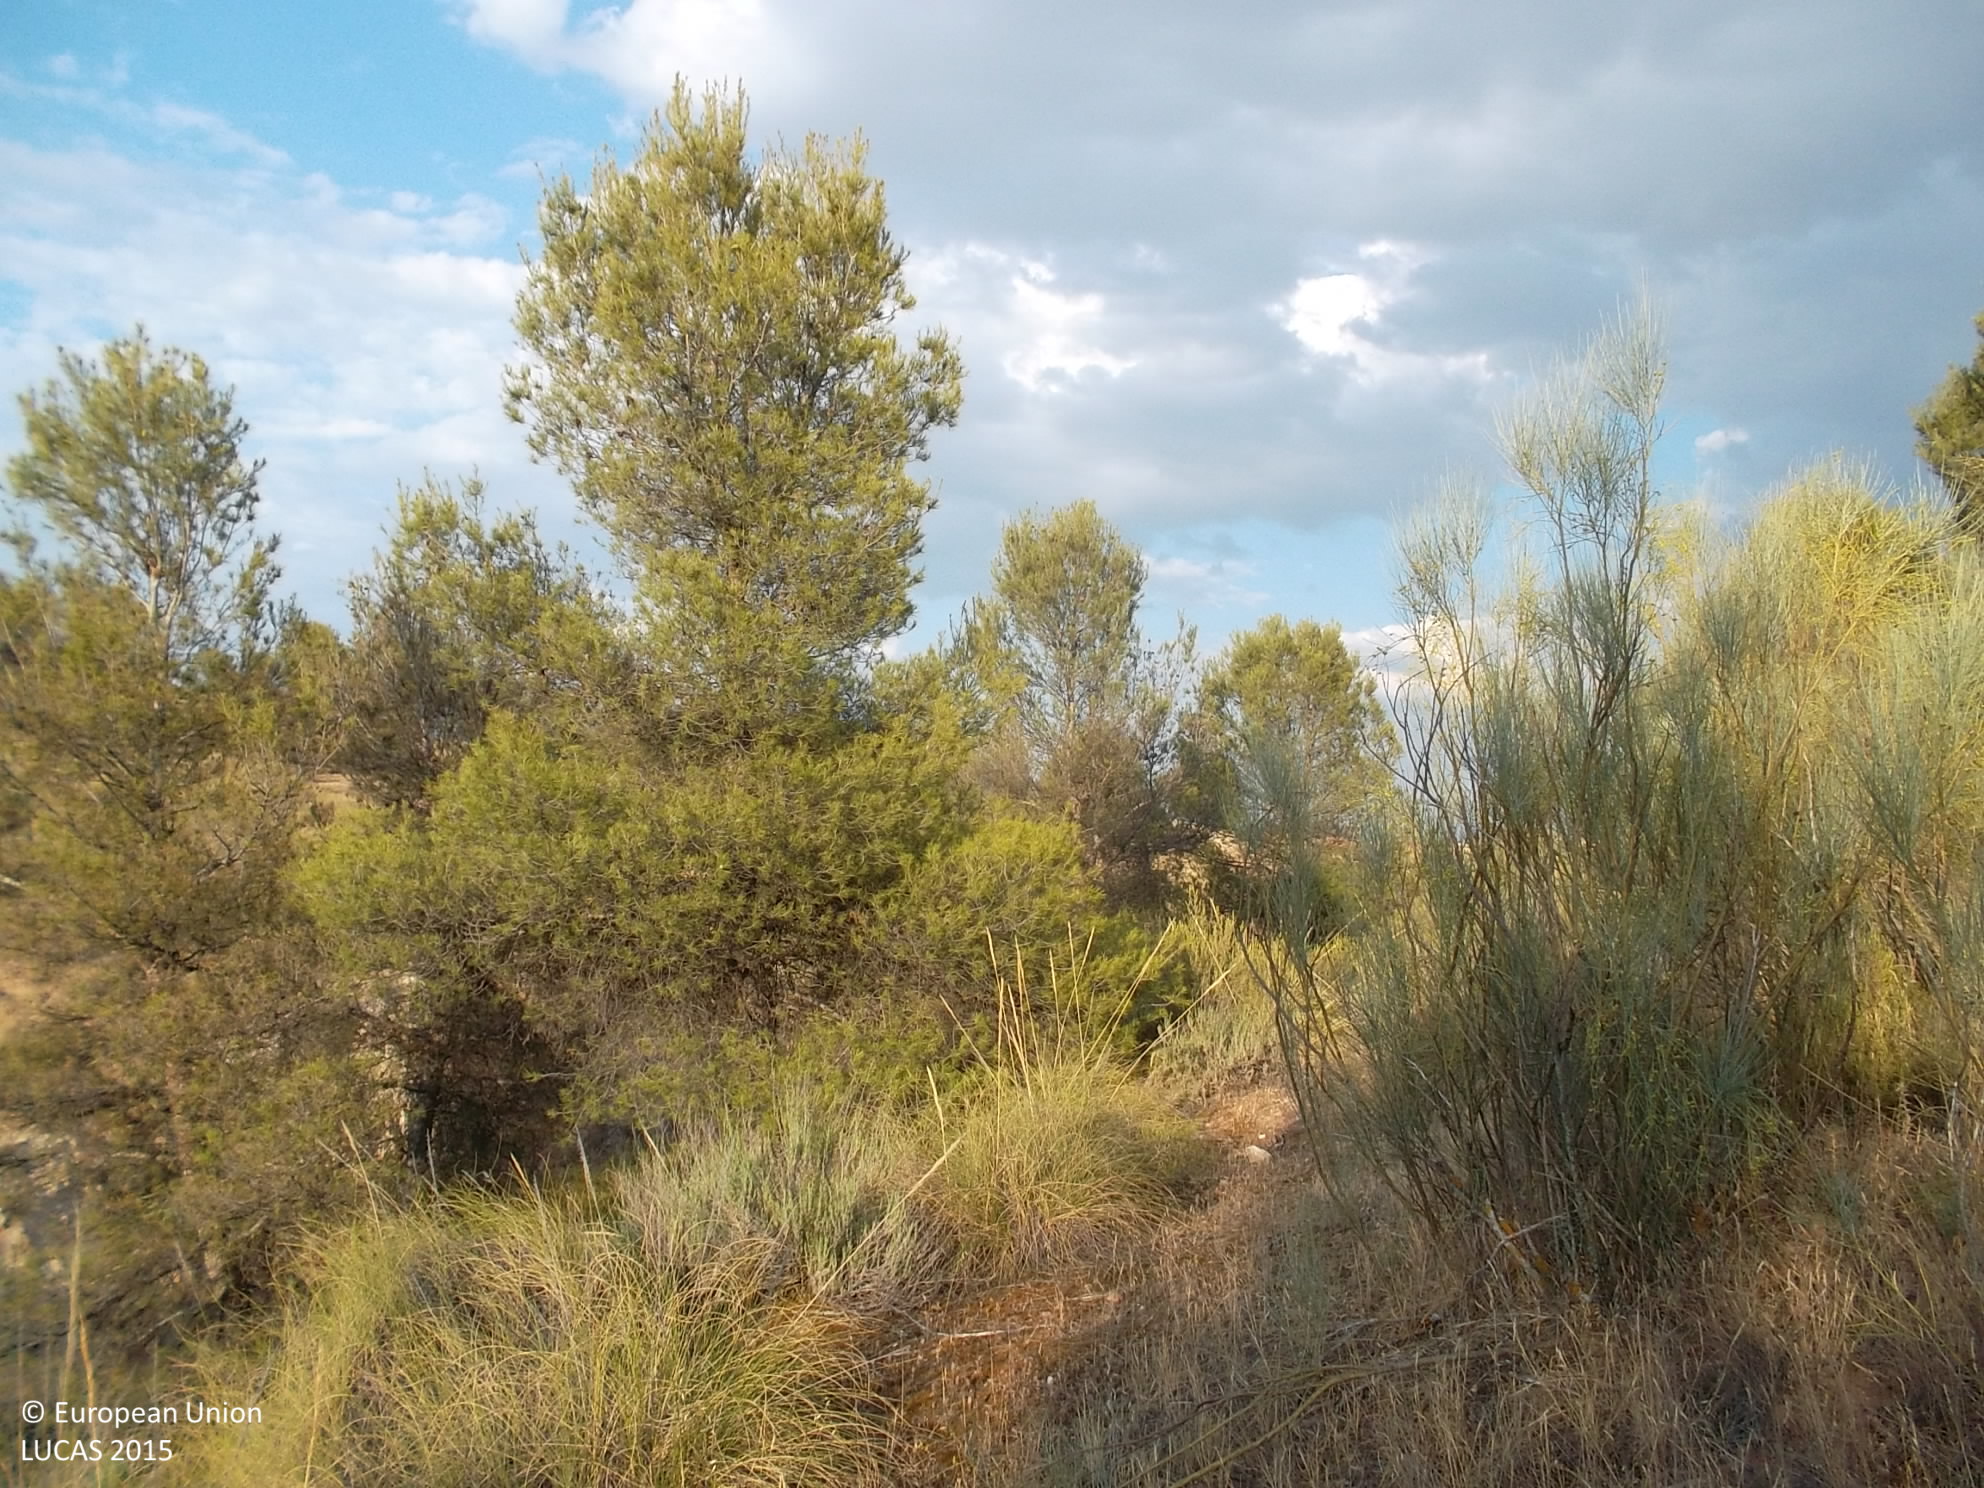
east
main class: Woodland
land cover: Pine dominated coniferous woodland
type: coniferous forest of the mediterranean region
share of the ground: 25 - 50 %
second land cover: Shrubland without tree cover
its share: 25 - 50 %
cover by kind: shrubs 40 %, coniferous forest trees 30 %, herbaceous plants 30 %
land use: Forestry
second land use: Agriculture (excluding fallow land and kitchen gardens)
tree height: > 5 m
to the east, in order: Pine dominated coniferous woodland; Shrubland without tree cover; Rivers and streams; Broadleaved woodland; Pine dominated coniferous woodland; Other bare soil
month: June
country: ES
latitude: 37.8097
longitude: -3.2285
